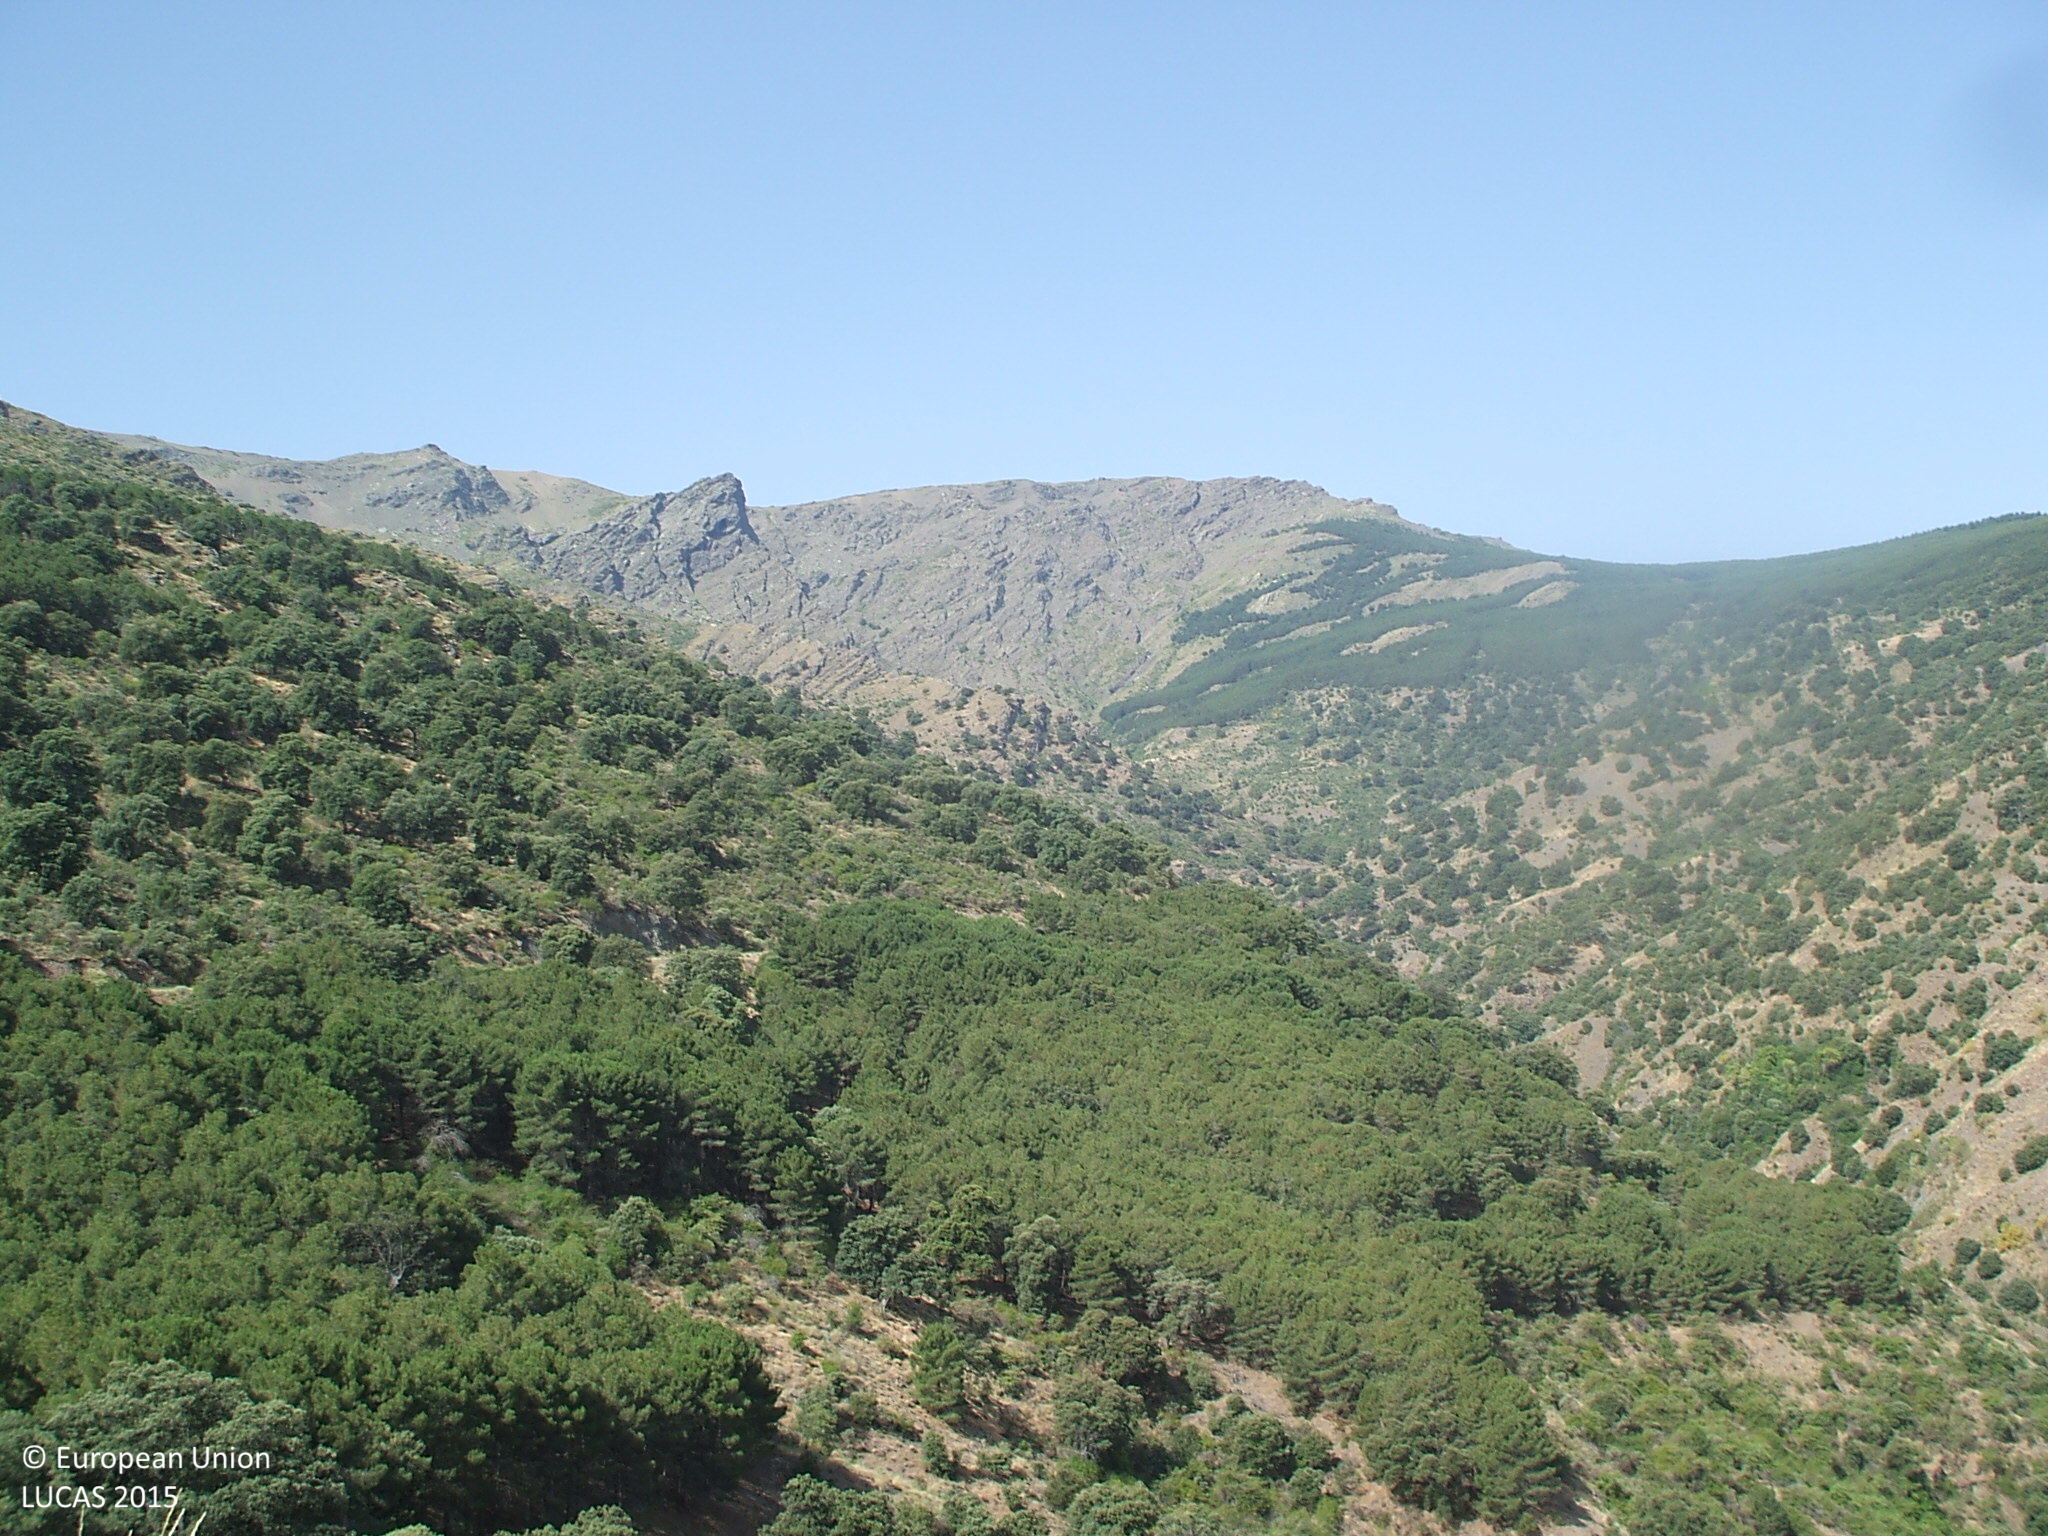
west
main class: Woodland
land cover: Other mixed woodland
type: coniferous forest of the mediterranean region
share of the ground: 25 - 50 %
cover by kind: coniferous forest trees 40 %, broadleaved forest trees 30 %, shrubs 30 %
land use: Semi-natural and natural areas not in use
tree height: > 5 m
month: June
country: ES
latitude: 37.1110
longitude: -2.8445
